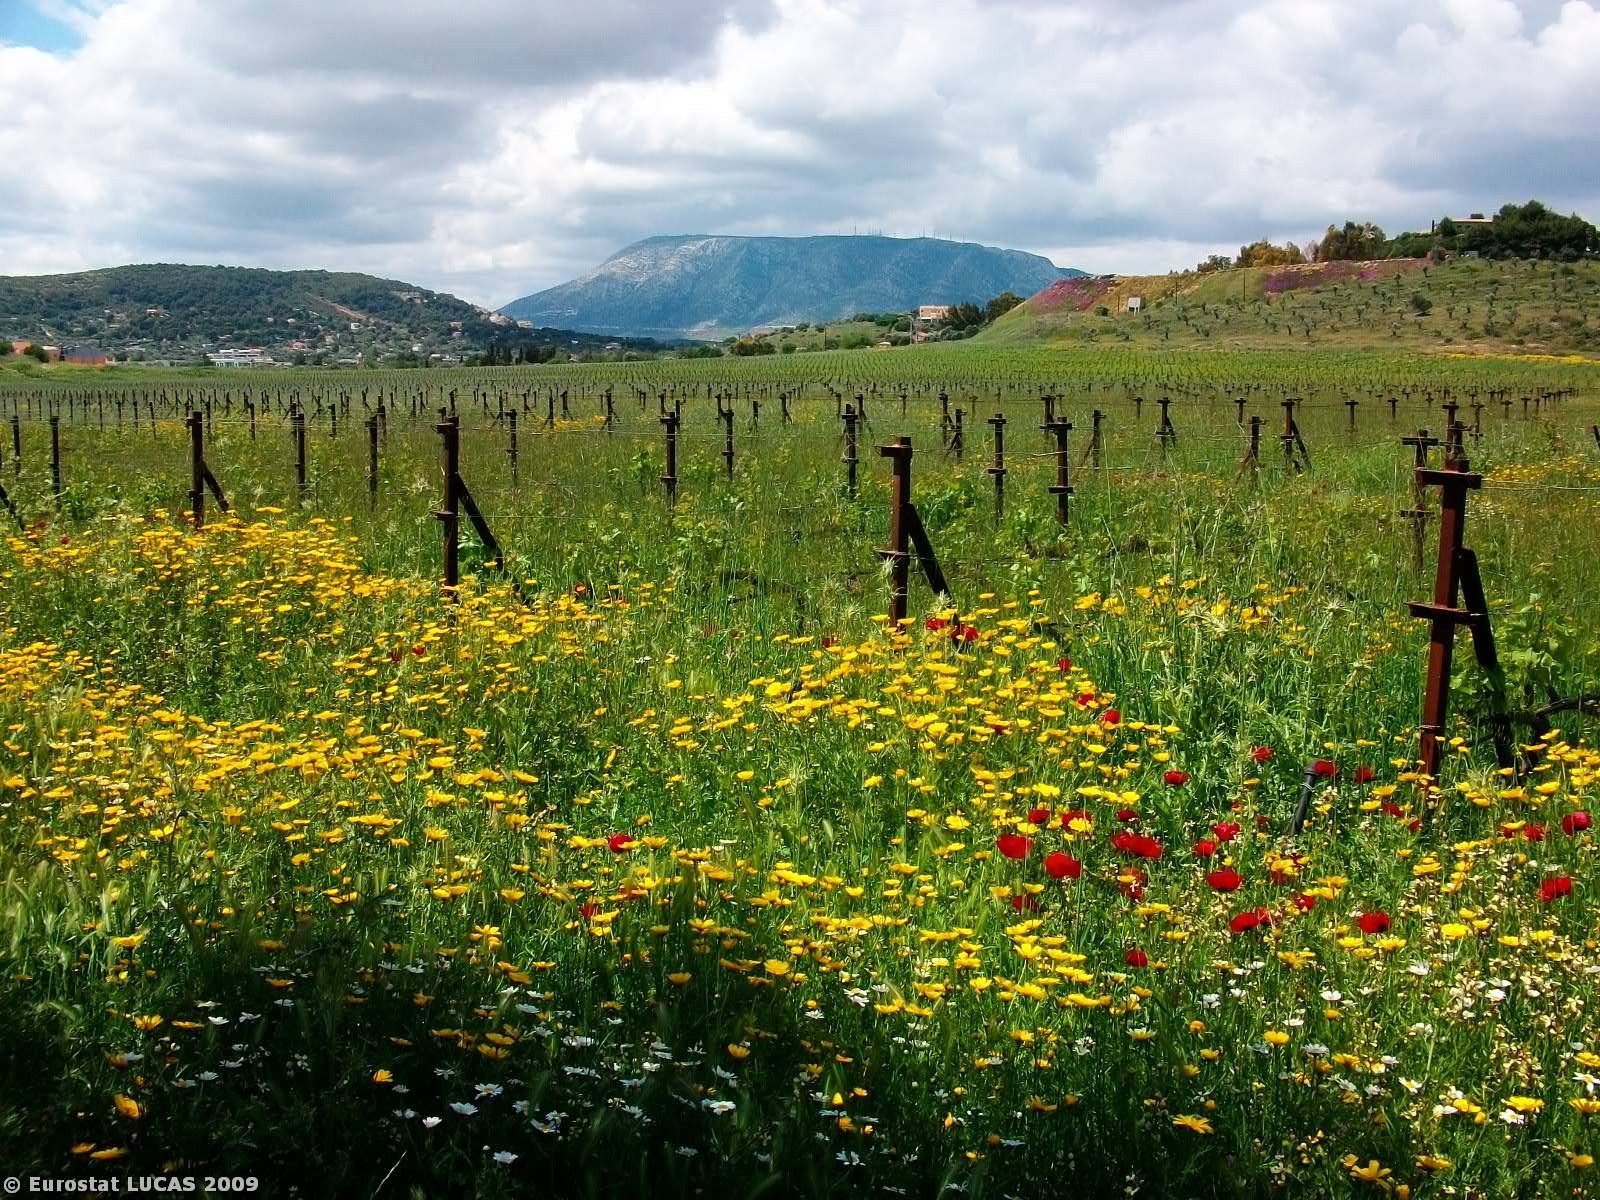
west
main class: Grassland
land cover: Grassland without tree/shrub cover
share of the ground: > 75 %
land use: Unused
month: May
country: GR
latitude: 37.9874
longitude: 23.9076
